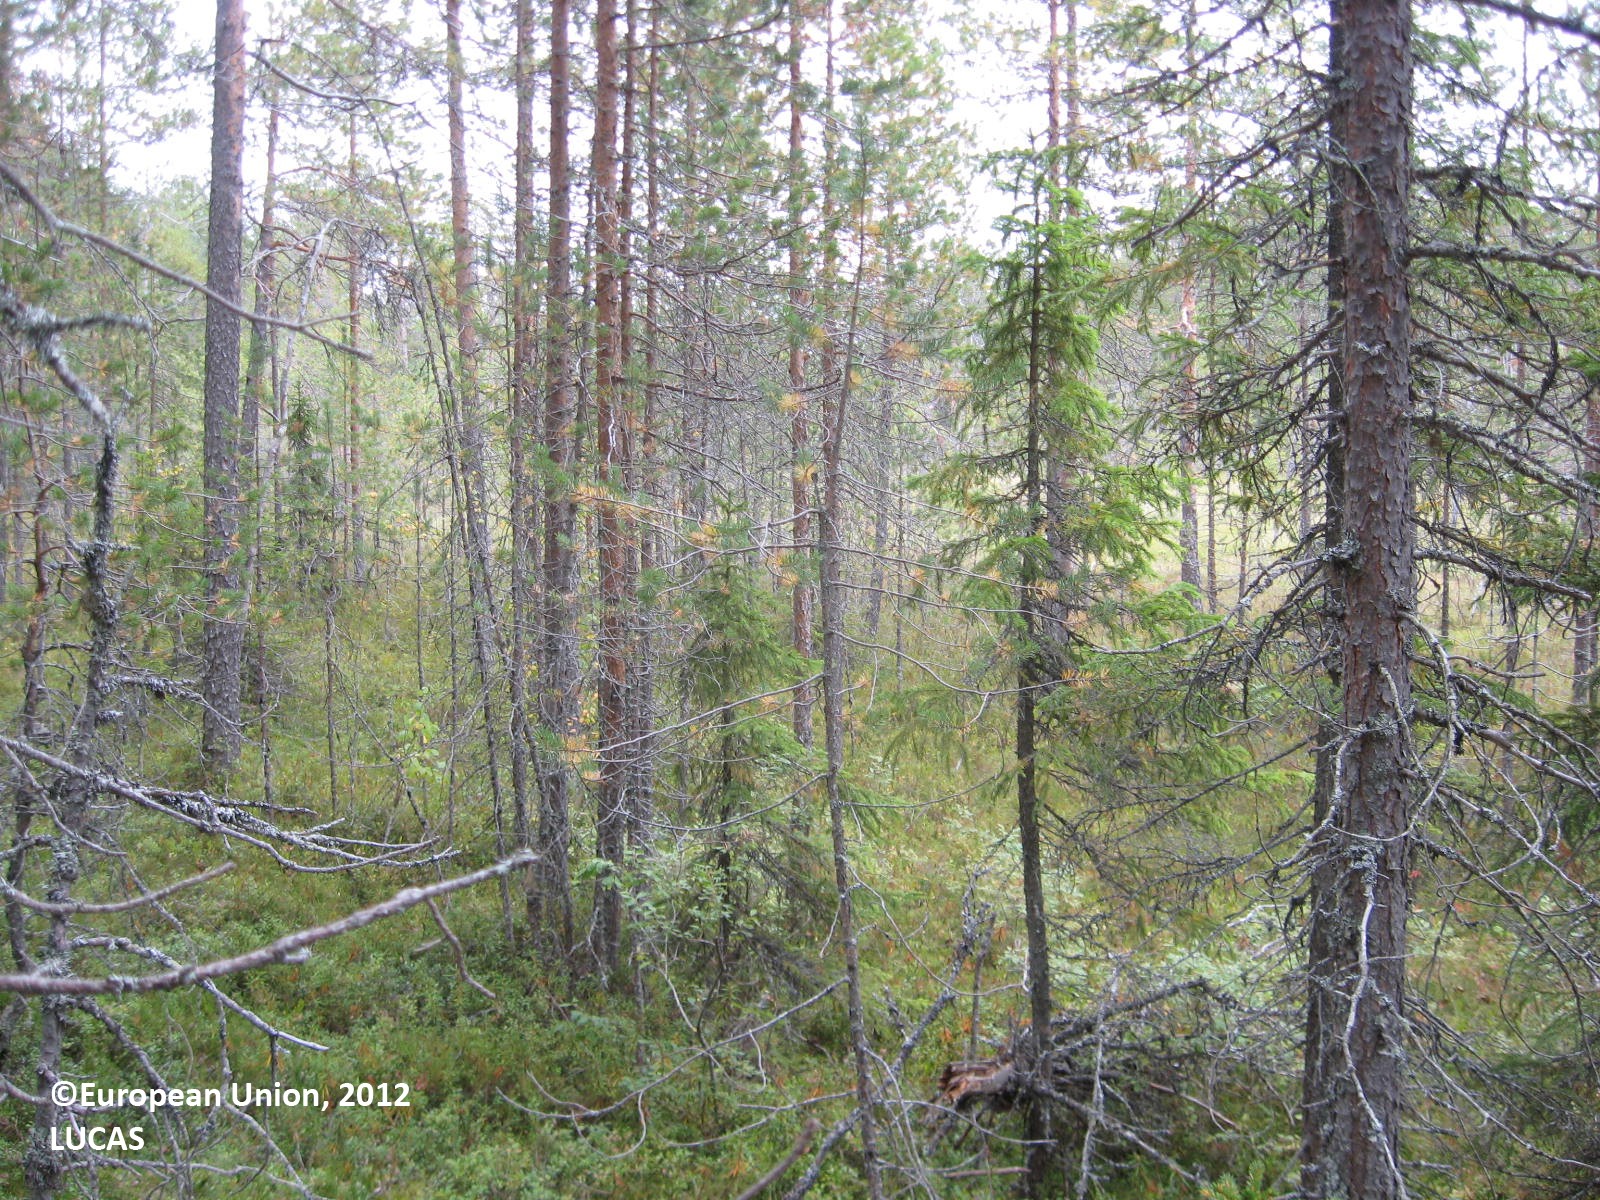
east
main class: Woodland
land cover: Pine dominated coniferous woodland
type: boreal forest
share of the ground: > 75 %
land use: Forestry
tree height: > 5 m
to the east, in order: Pine dominated coniferous woodland; Peatbogs
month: August
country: FI
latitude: 63.9534
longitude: 29.5108
